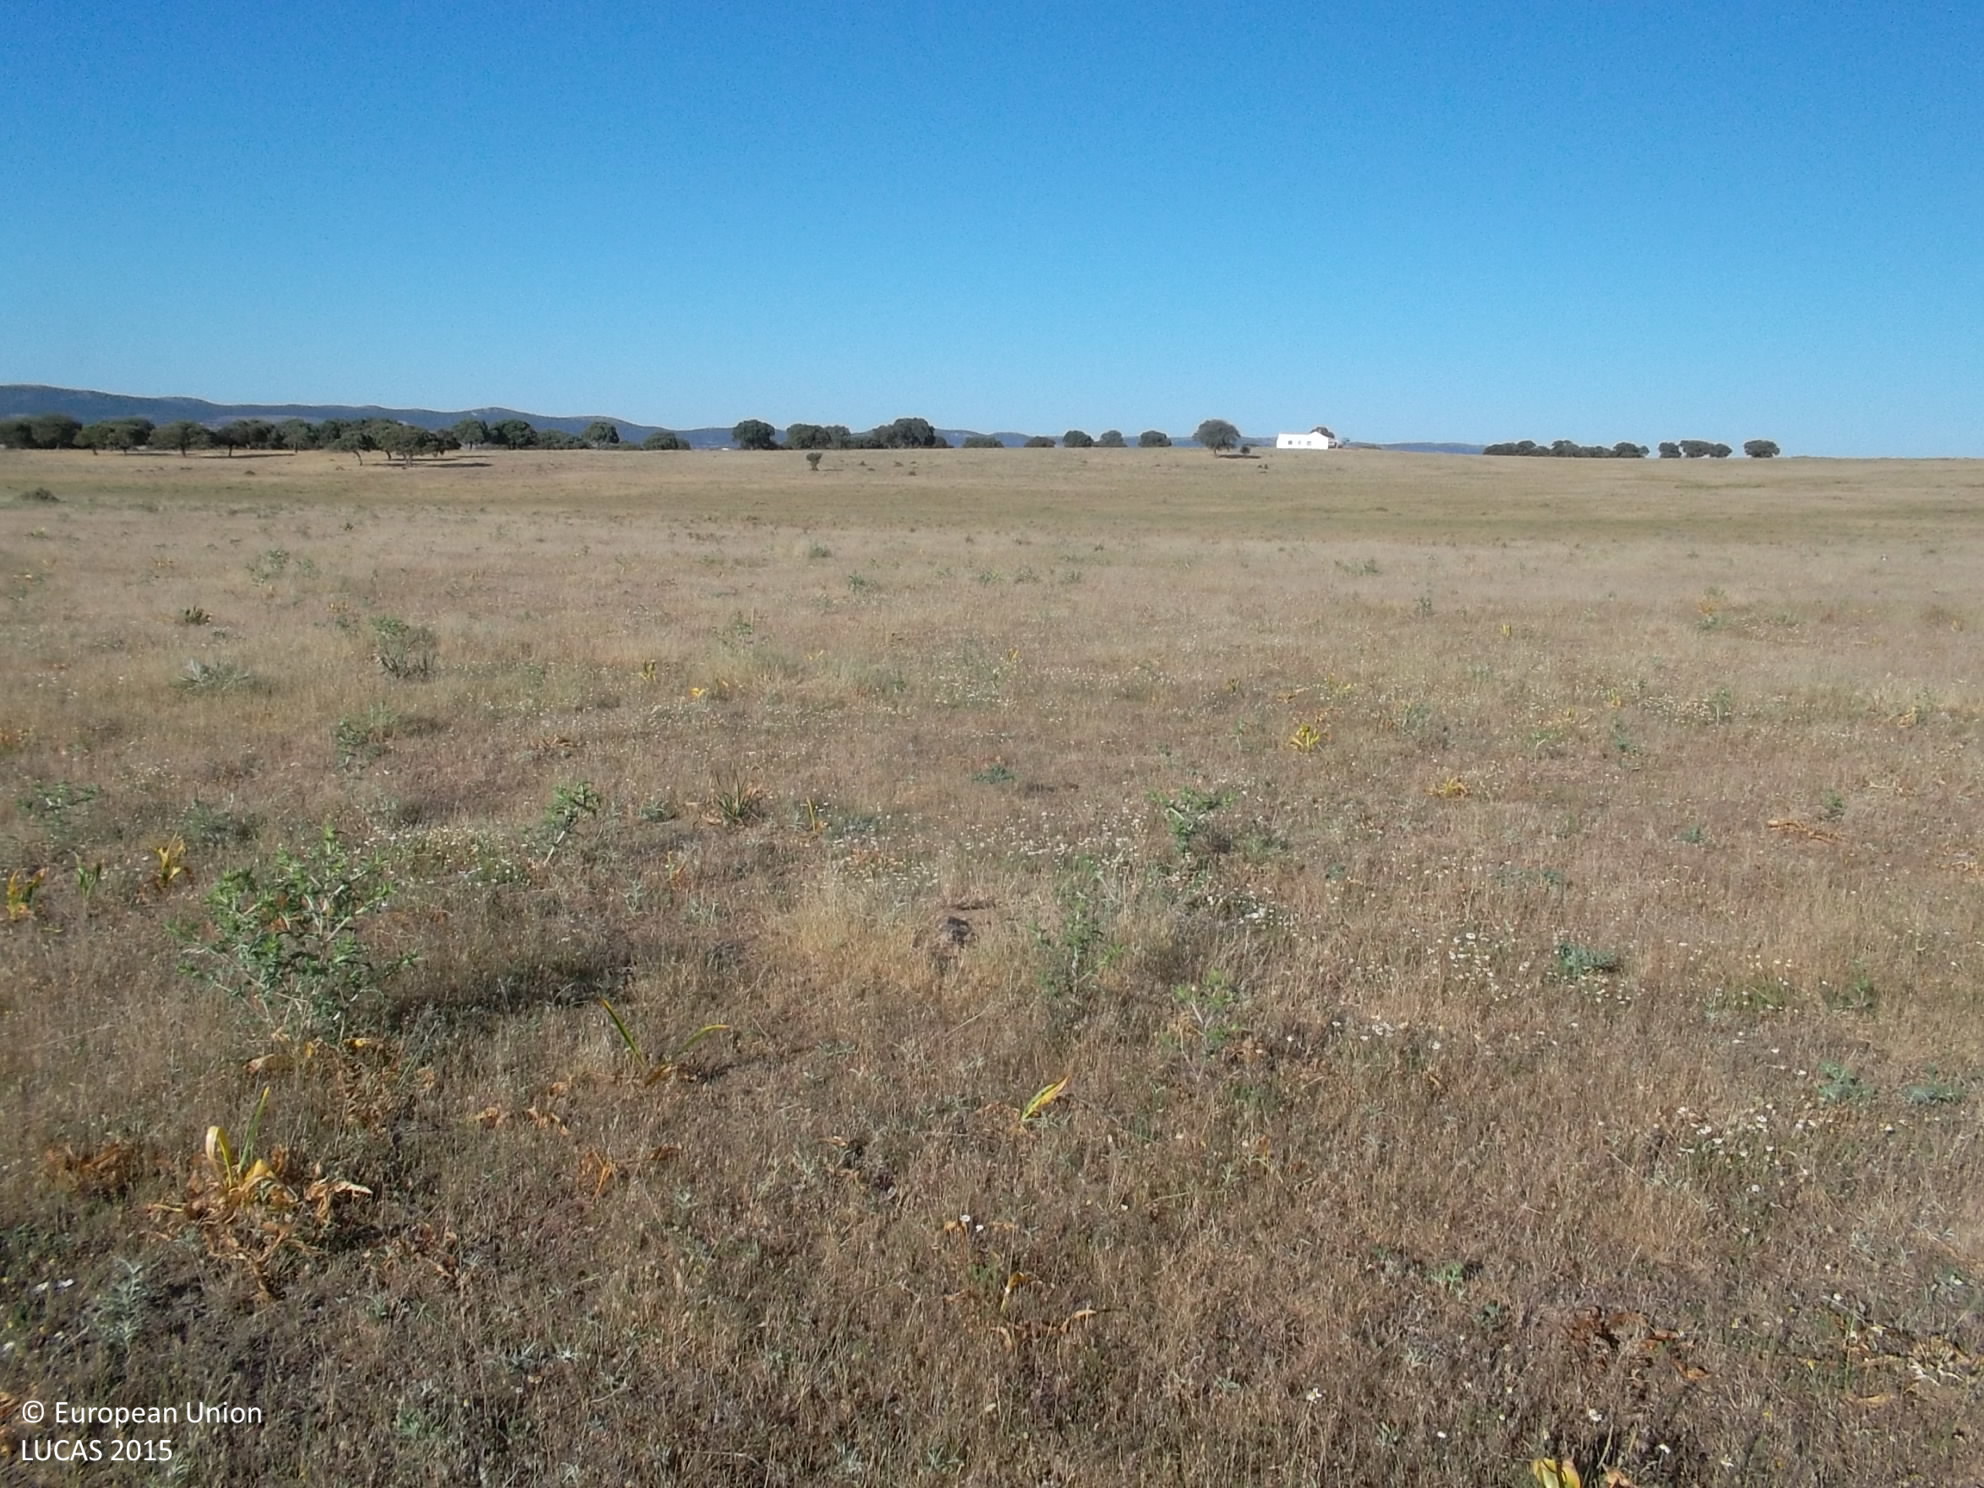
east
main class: Grassland
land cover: Grassland without tree/shrub cover
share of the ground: > 75 %
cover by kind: herbaceous plants 95 %, shrubs 5 %
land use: Agriculture (excluding fallow land and kitchen gardens)
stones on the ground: < 10 %
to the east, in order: Grassland without tree/shrub cover
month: May
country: ES
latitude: 38.6174
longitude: -4.4818
